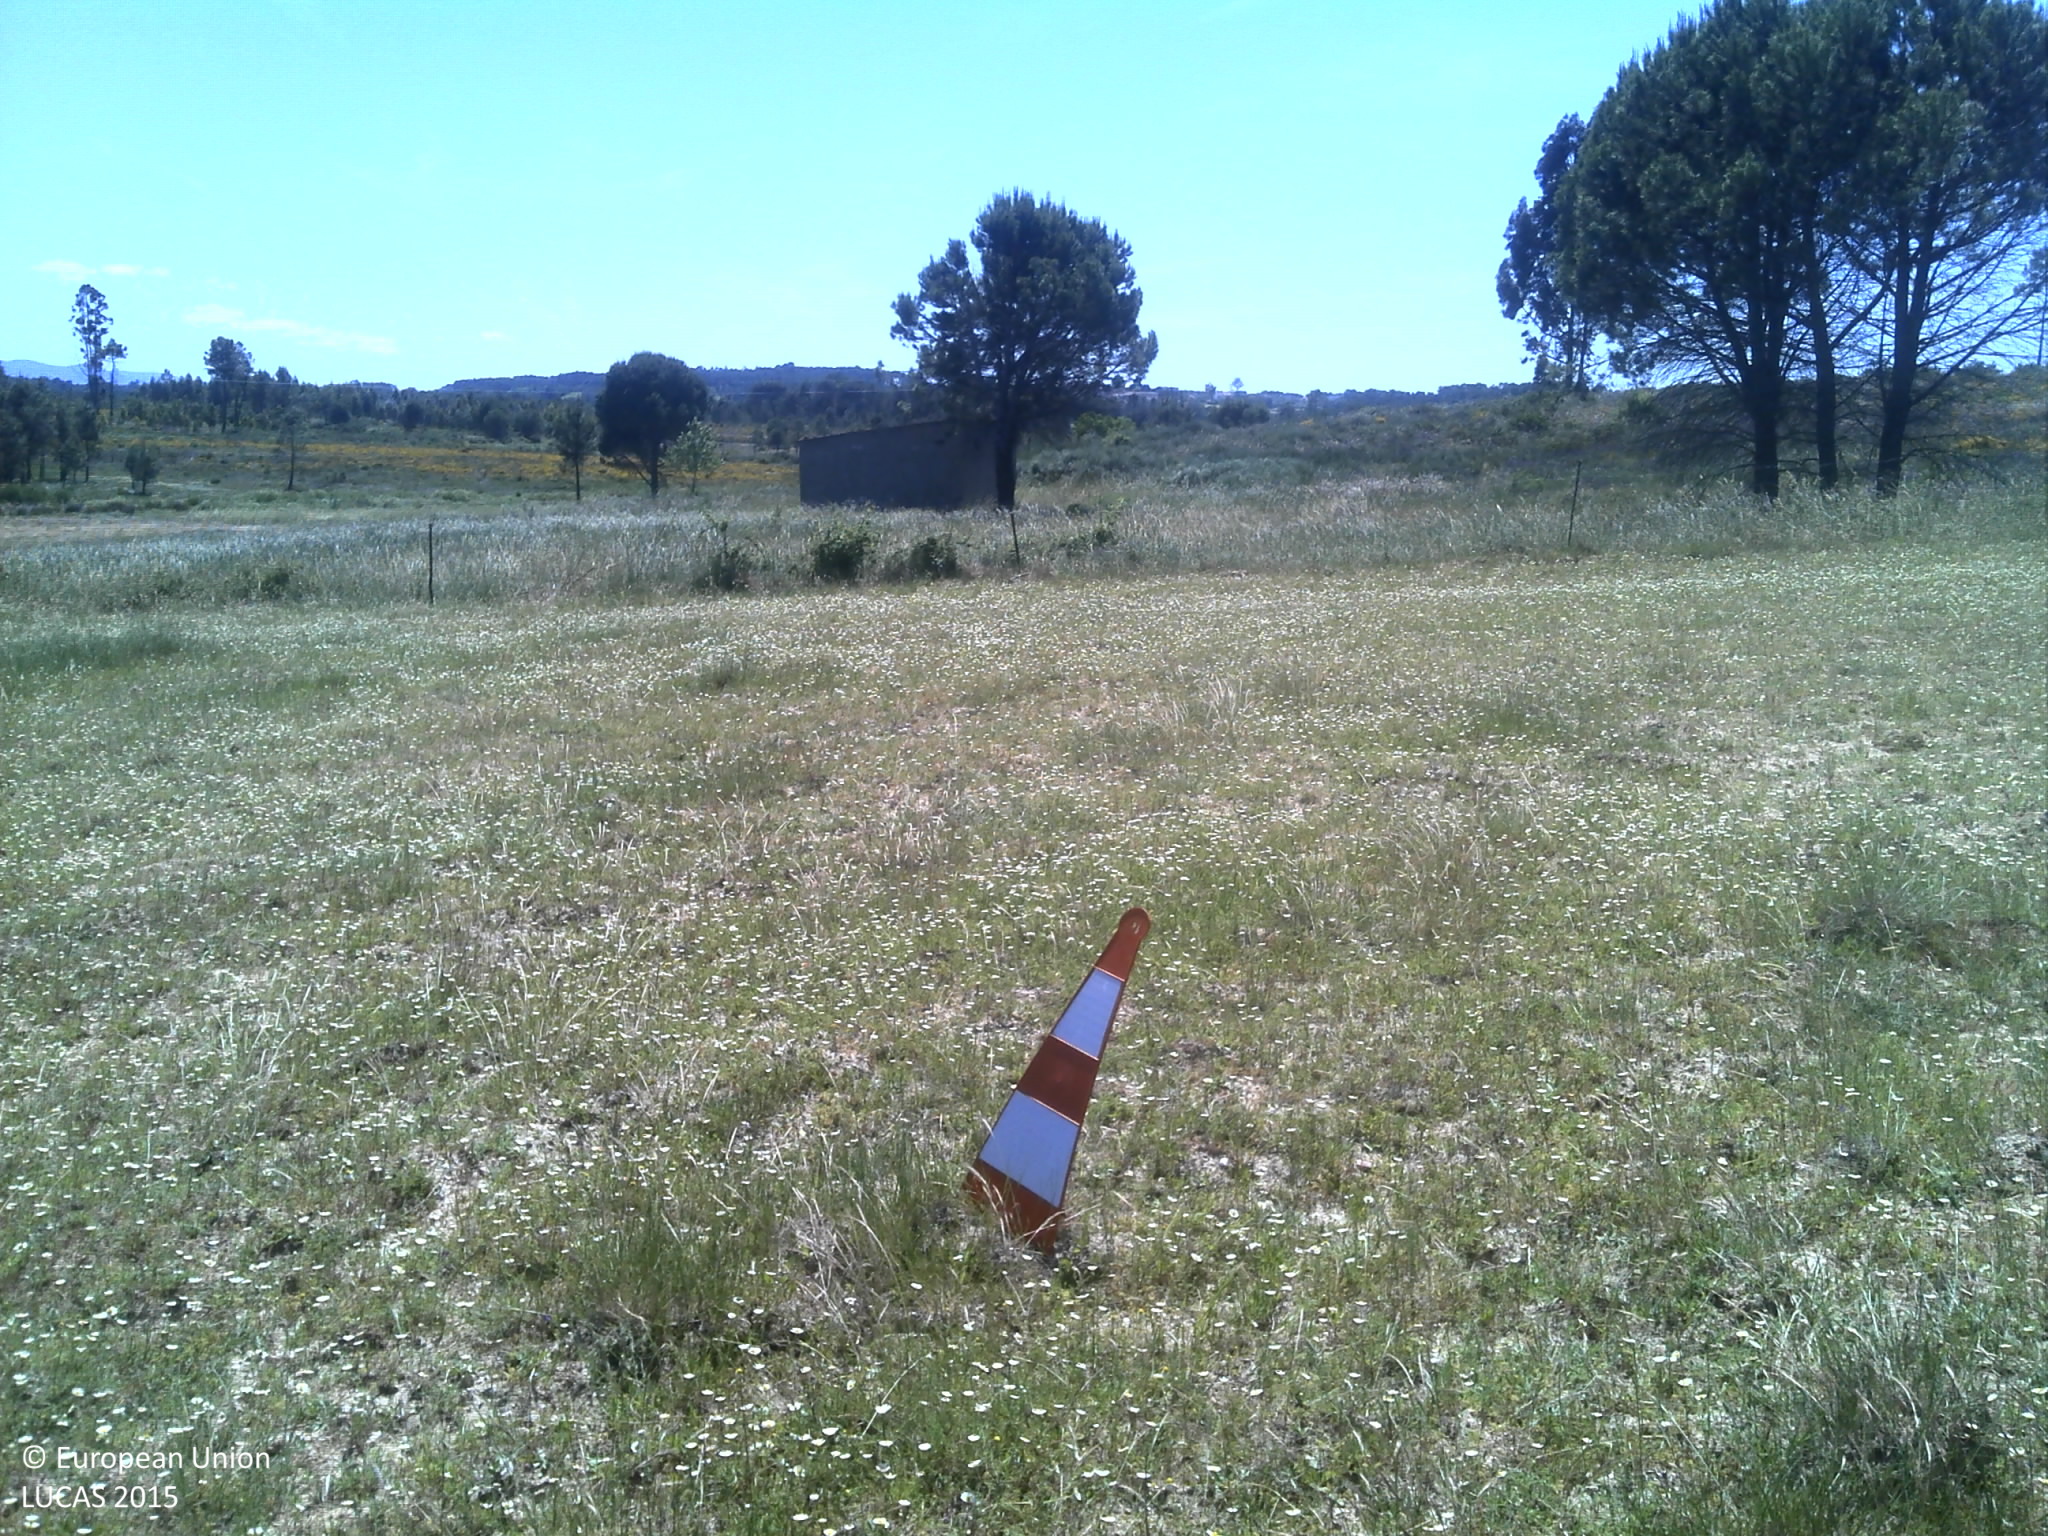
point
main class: Grassland
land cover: Grassland without tree/shrub cover
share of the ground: 25 - 50 %
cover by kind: herbaceous plants 50 %, unconsolidated bare surface 50 %
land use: Agriculture (excluding fallow land and kitchen gardens)
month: May
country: PT
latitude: 40.4845
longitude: -7.7296
